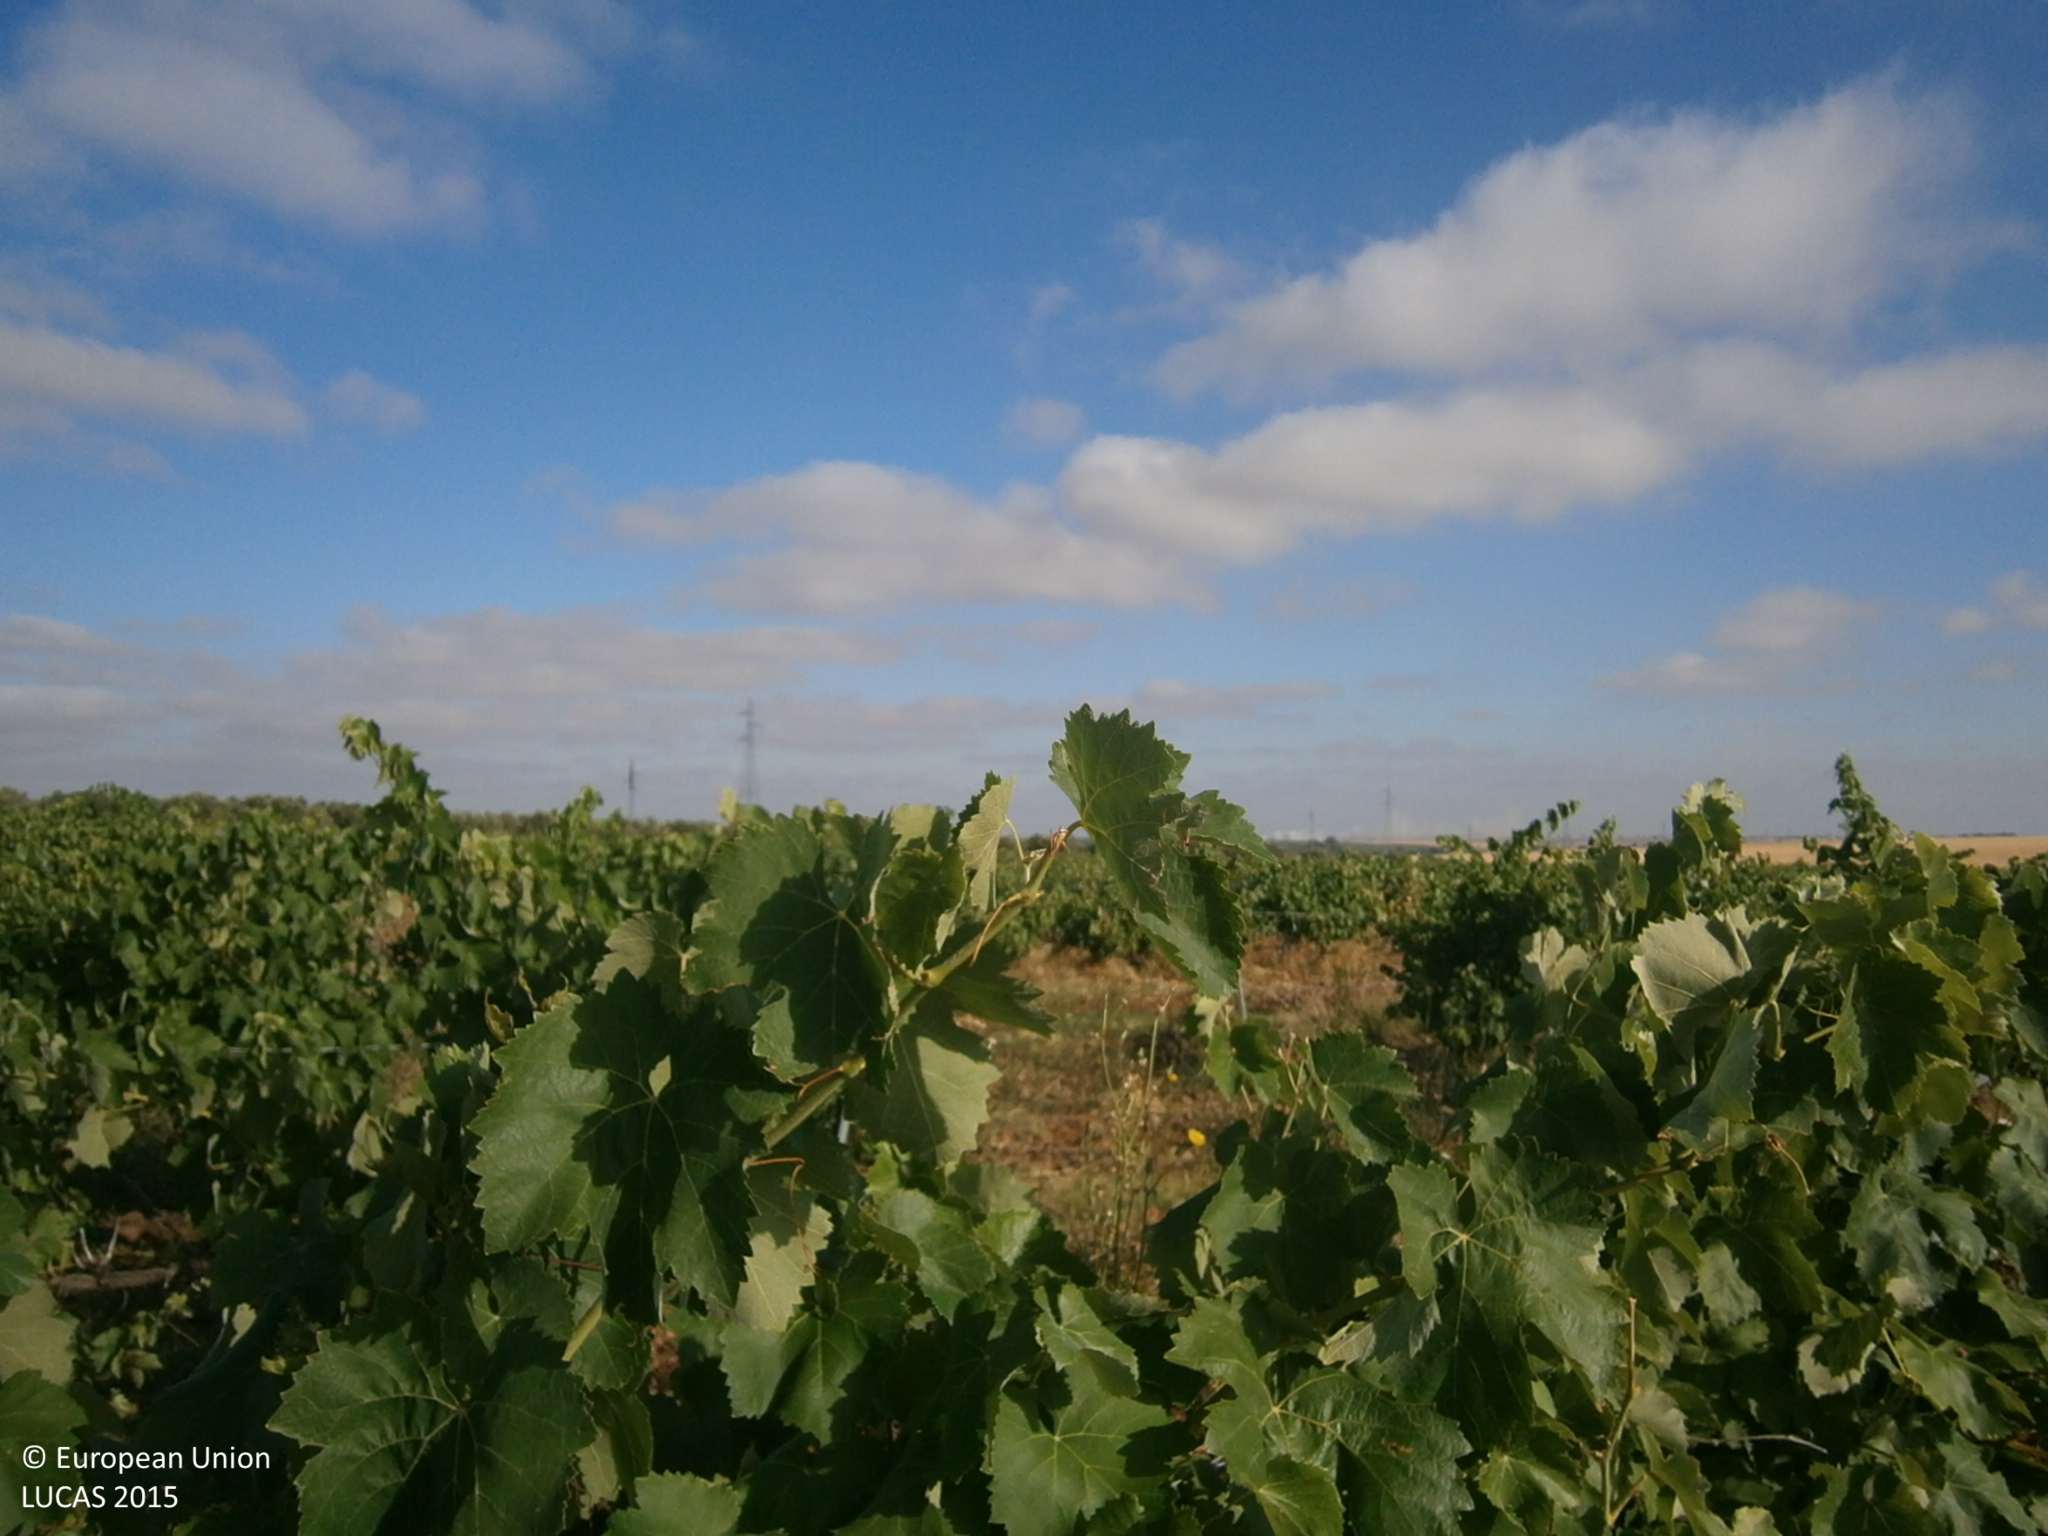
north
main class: Cropland
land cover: Vineyards
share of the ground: 25 - 50 %
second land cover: Spontaneously vegetated surfaces
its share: 25 - 50 %
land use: Agriculture (excluding fallow land and kitchen gardens)
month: June
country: ES
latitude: 38.7153
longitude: -6.7967
